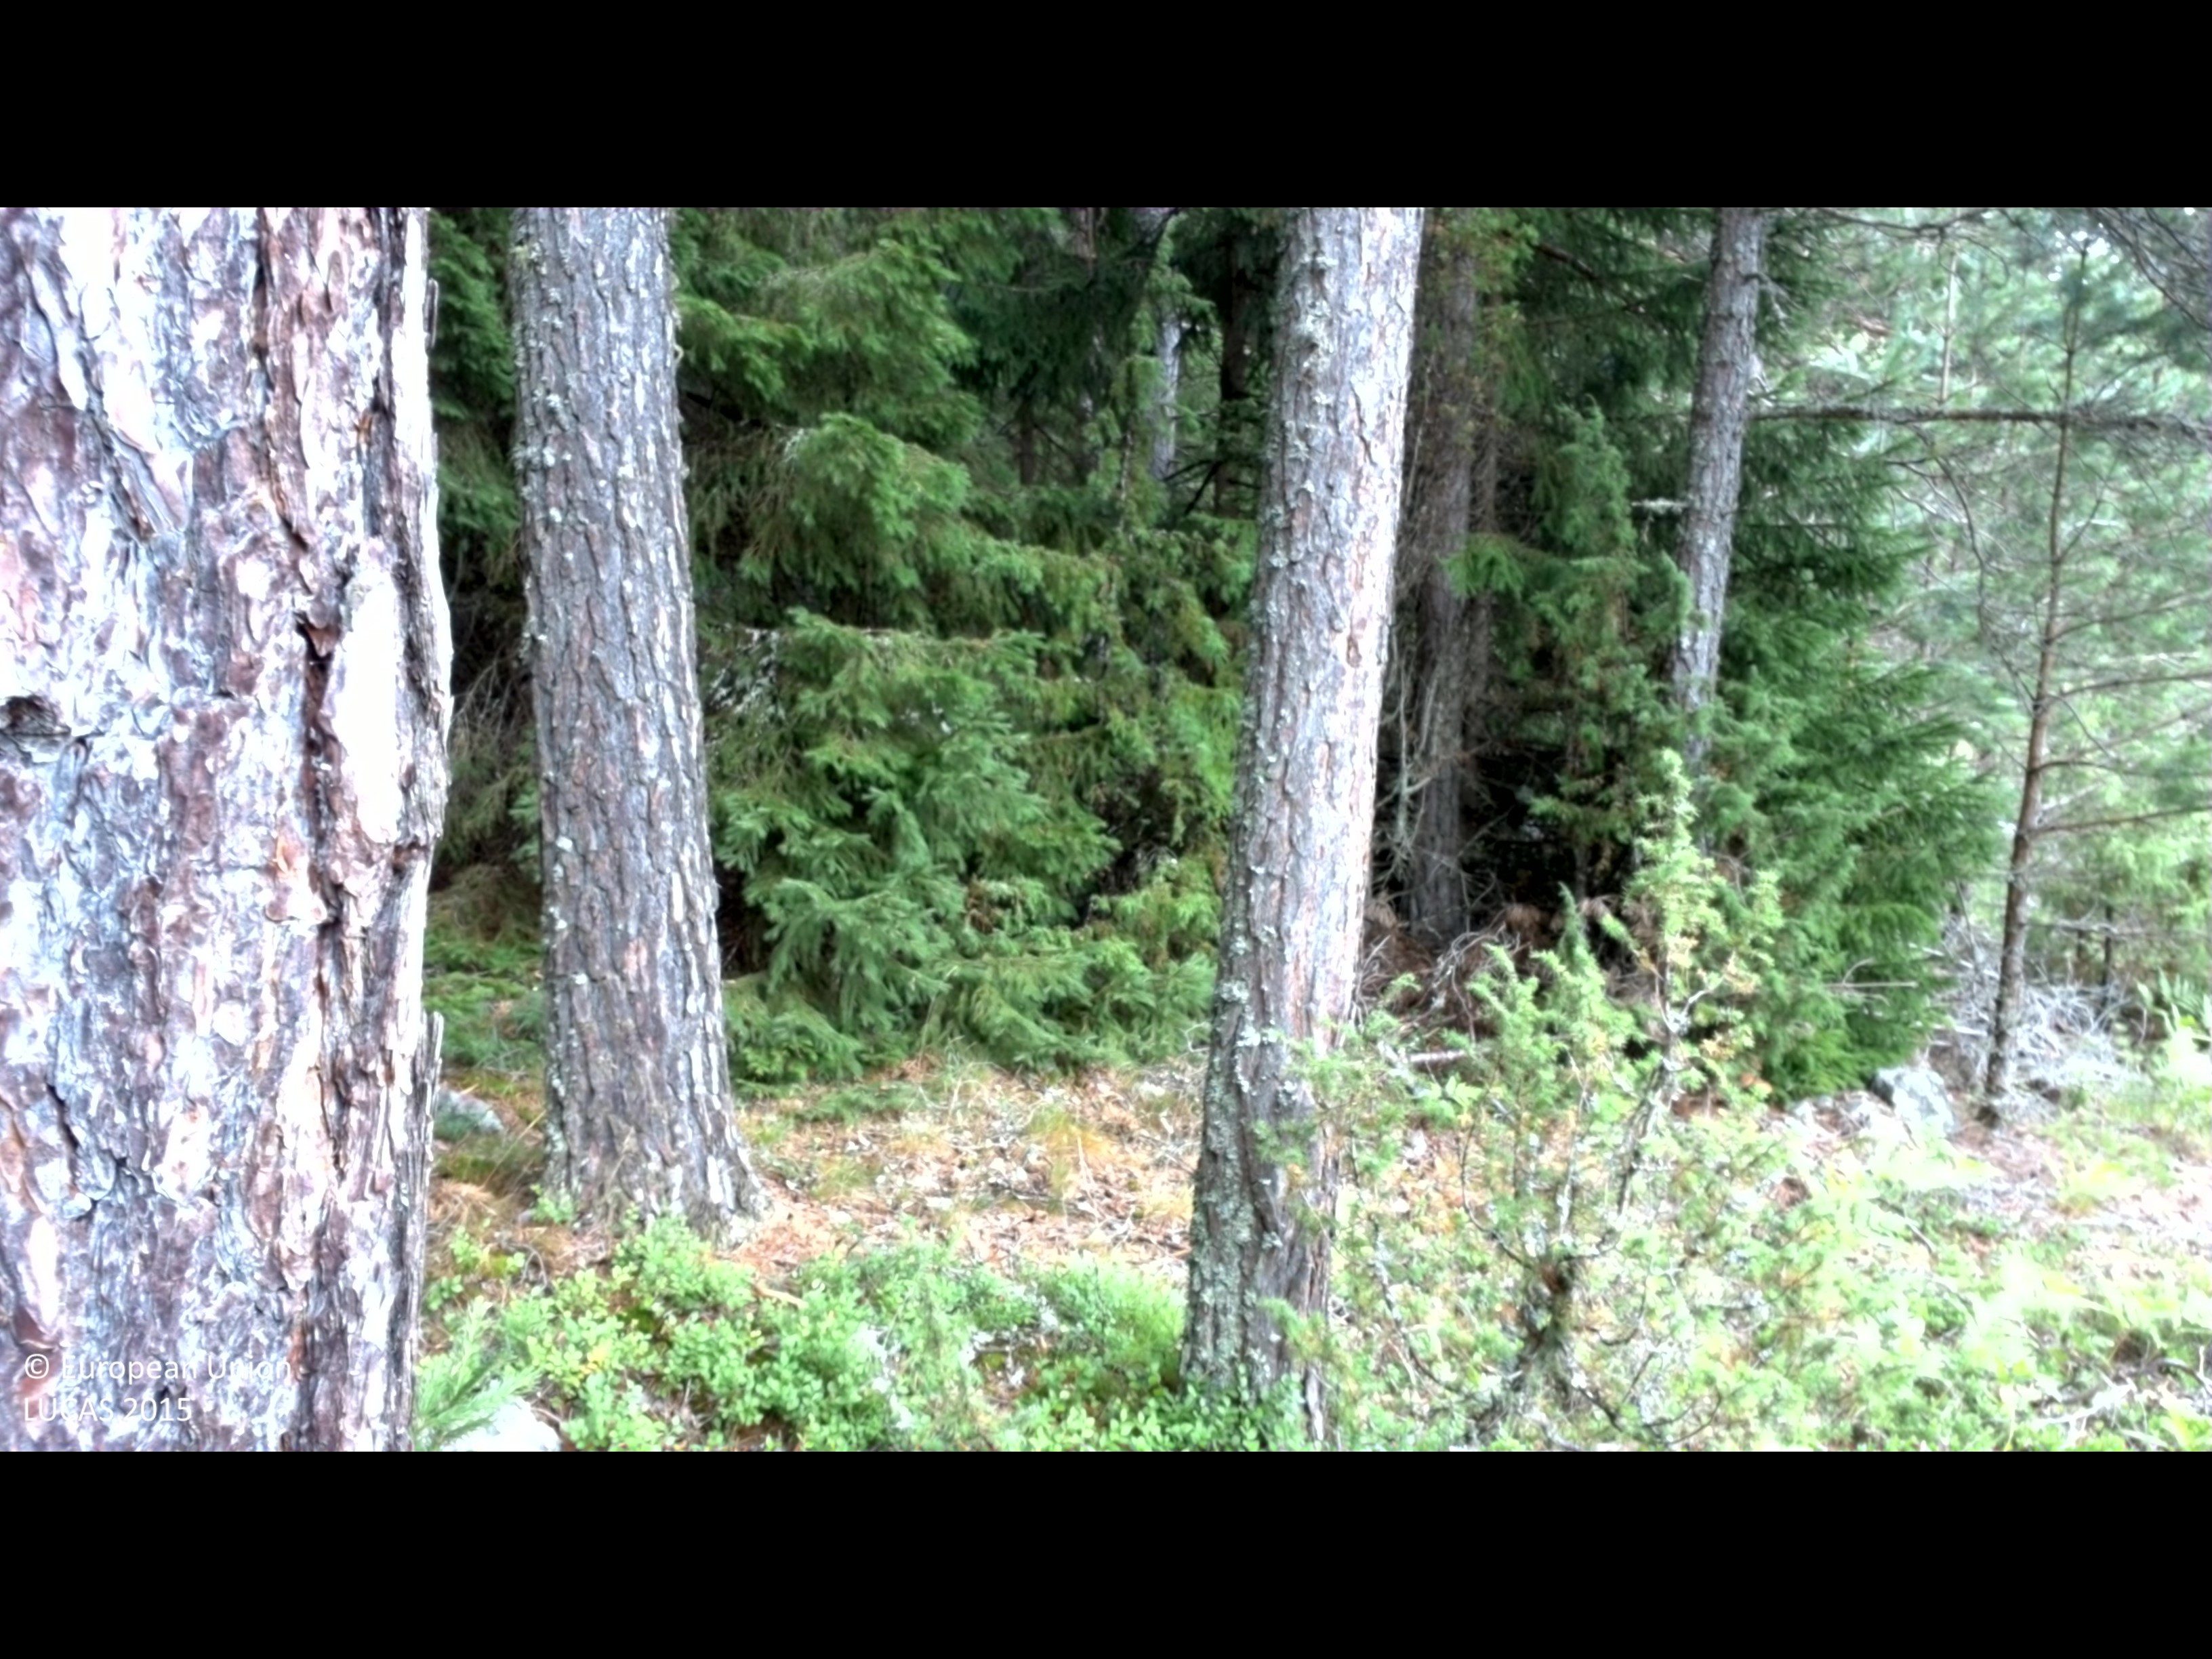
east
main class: Woodland
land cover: Pine dominated coniferous woodland
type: boreal forest
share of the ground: > 75 %
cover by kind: coniferous forest trees 80 %, shrubs 15 %, lichens and mosses 5 %
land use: Forestry
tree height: > 5 m
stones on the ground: 25 - 50 %
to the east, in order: Pine dominated coniferous woodland; Tracks; Spontaneously vegetated surfaces; Spruce dominated coniferous woodland; Ditches and canals; Groves; Grassland without tree/shrub cover; Spruce dominated coniferous woodland
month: July
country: SE
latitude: 58.3621
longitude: 16.2688
